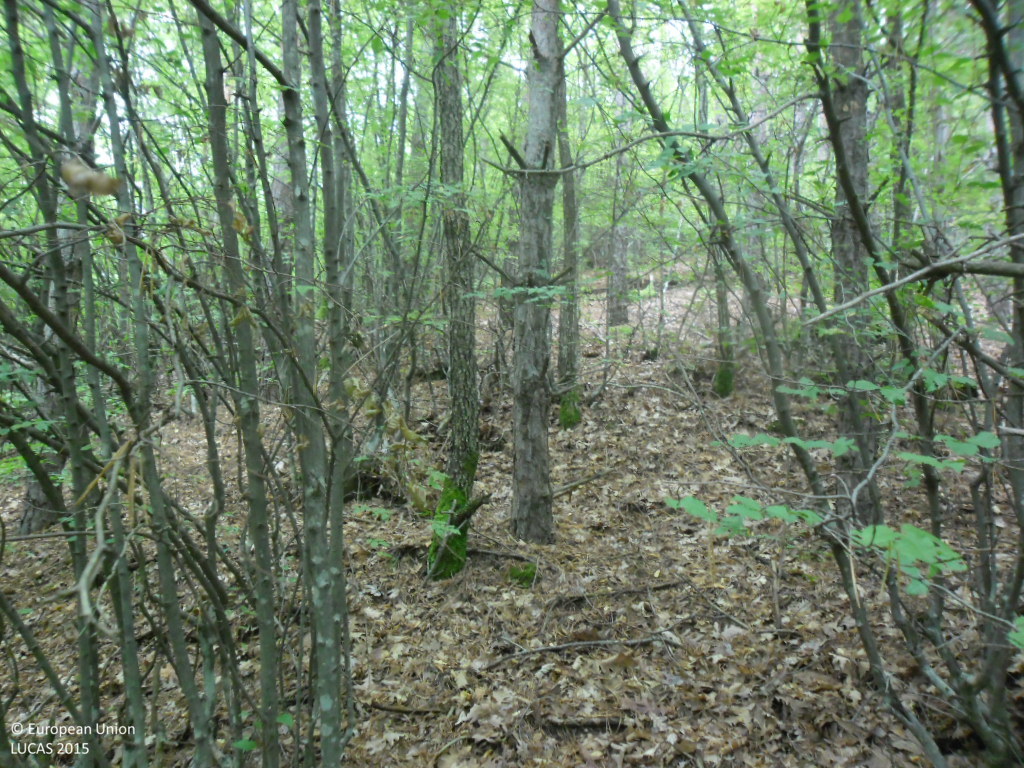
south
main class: Woodland
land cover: Pine dominated mixed woodland
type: hemiboreal forest and nemoral coniferous forest and mixed broadleaved-coniferous forest
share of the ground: > 75 %
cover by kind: coniferous forest trees 75 %, broadleaved forest trees 25 %
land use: Forestry
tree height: > 5 m
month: September
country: BG
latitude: 41.6147
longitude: 23.1129
